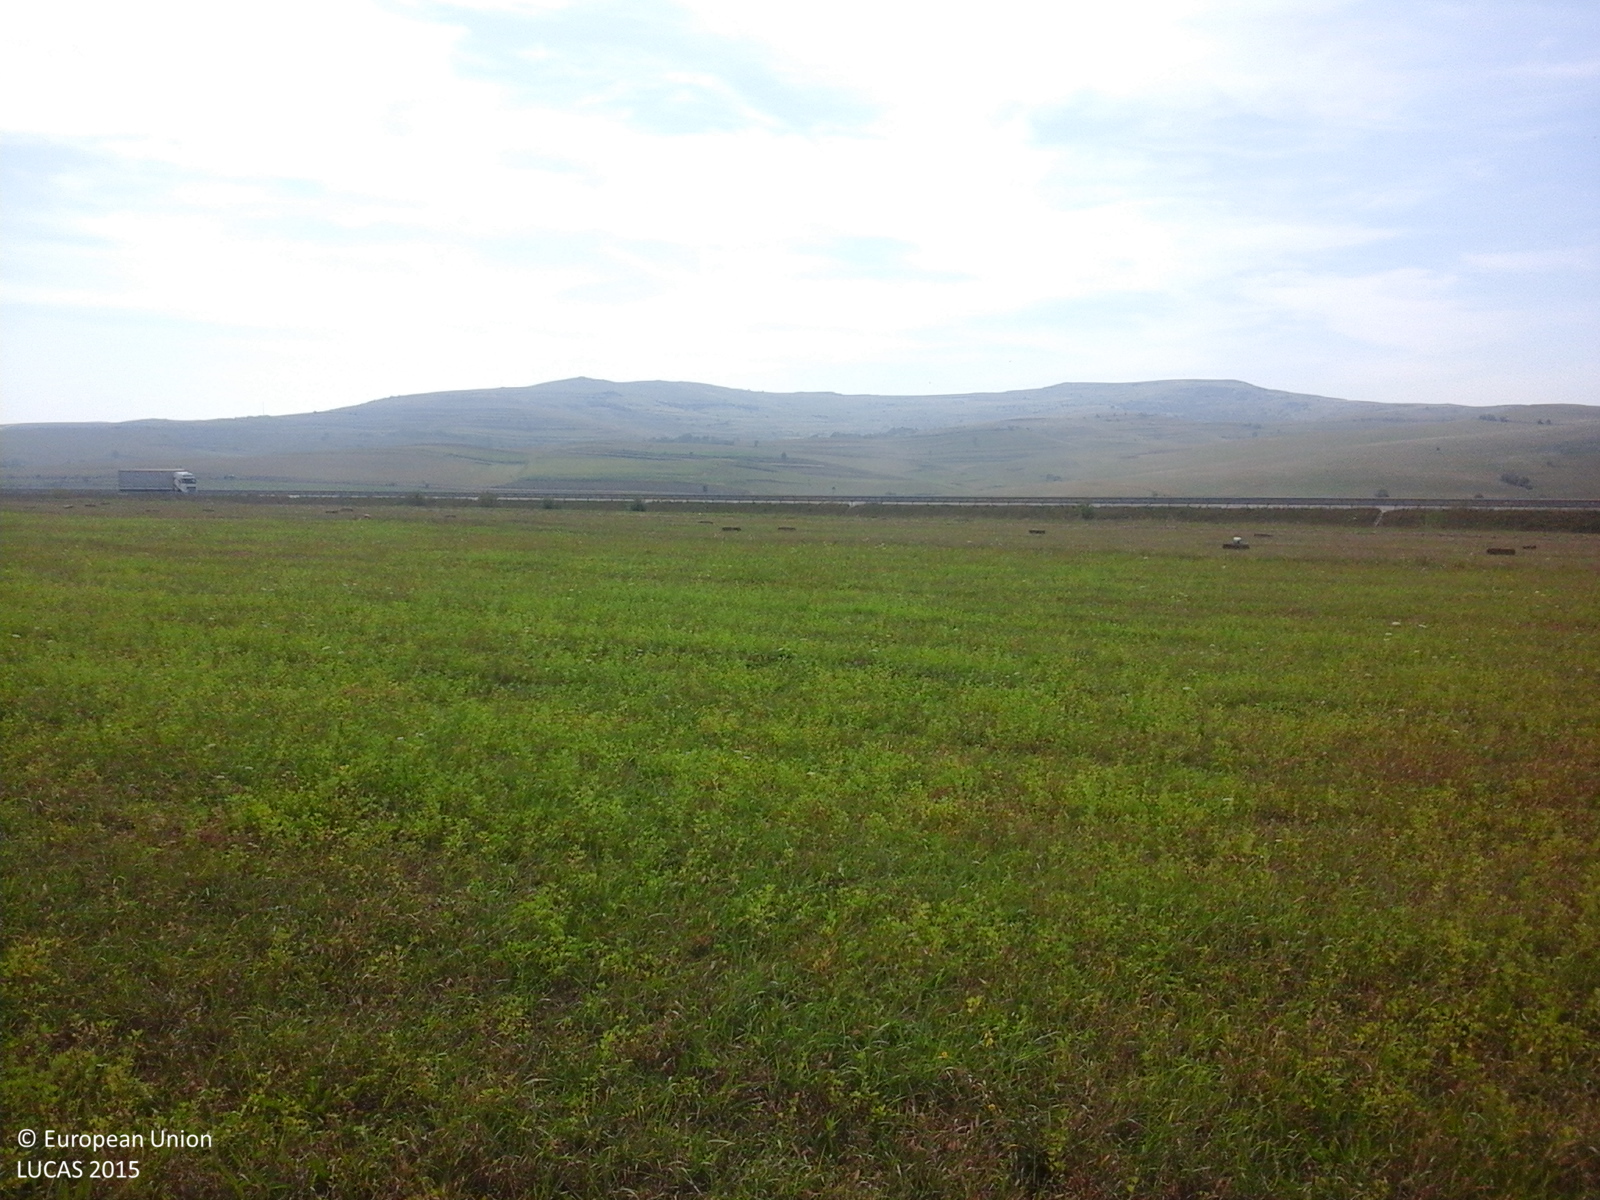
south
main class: Cropland
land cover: Lucerne
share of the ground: > 75 %
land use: Agriculture (excluding fallow land and kitchen gardens)
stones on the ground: < 10 %
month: September
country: RO
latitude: 46.6357
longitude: 23.5369
